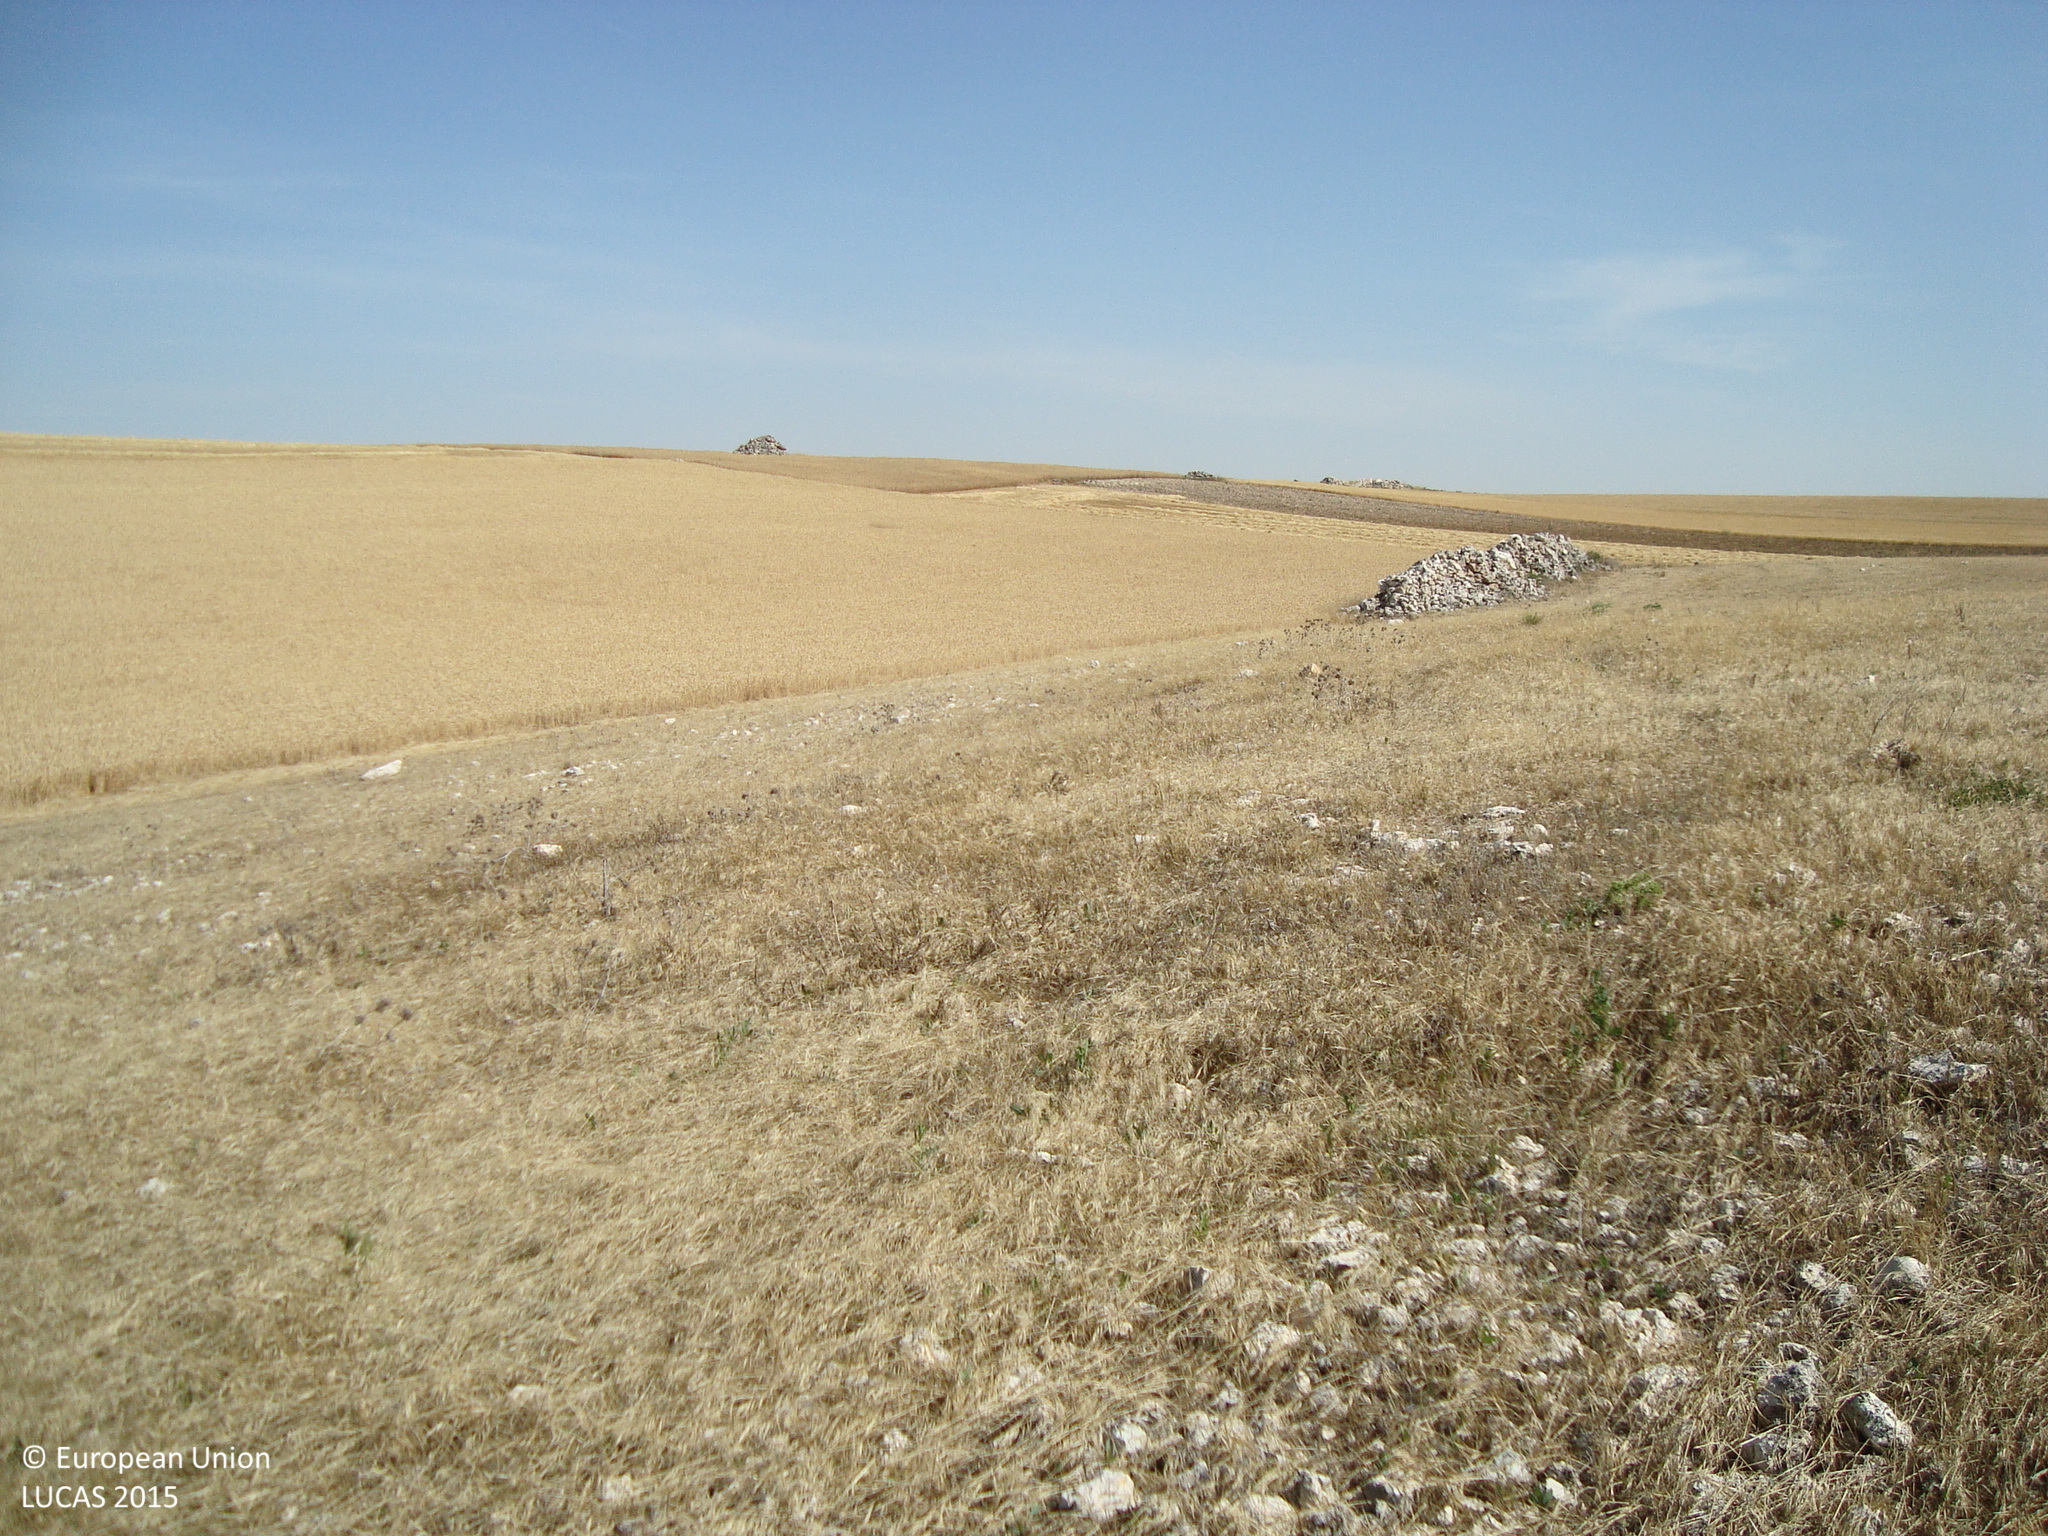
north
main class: Grassland
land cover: Grassland without tree/shrub cover
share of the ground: > 75 %
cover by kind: herbaceous plants 90 %, unconsolidated bare surface 10 %
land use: Abandoned areas
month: July
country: ES
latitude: 41.8409
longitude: -3.8706
